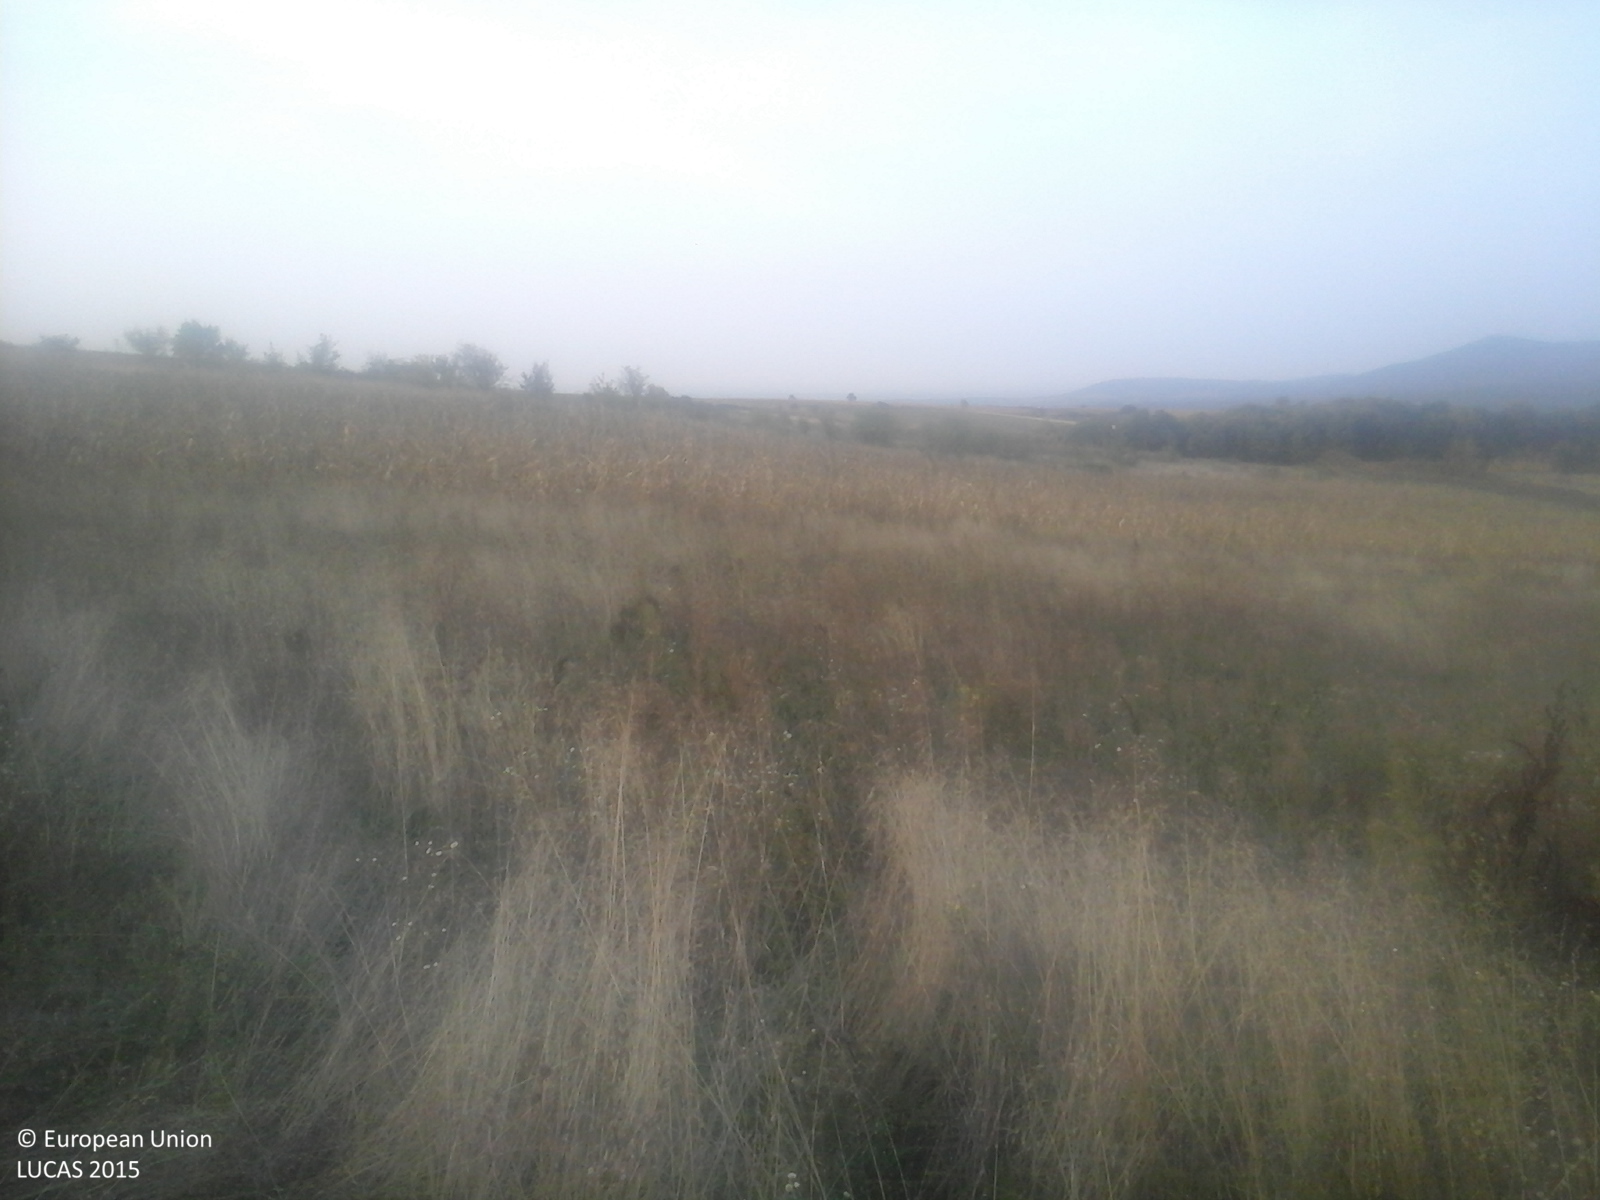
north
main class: Grassland
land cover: Spontaneously vegetated surfaces
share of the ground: > 75 %
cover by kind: herbaceous plants 100 %
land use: Fallow land
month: September
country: RO
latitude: 45.7066
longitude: 22.0242
